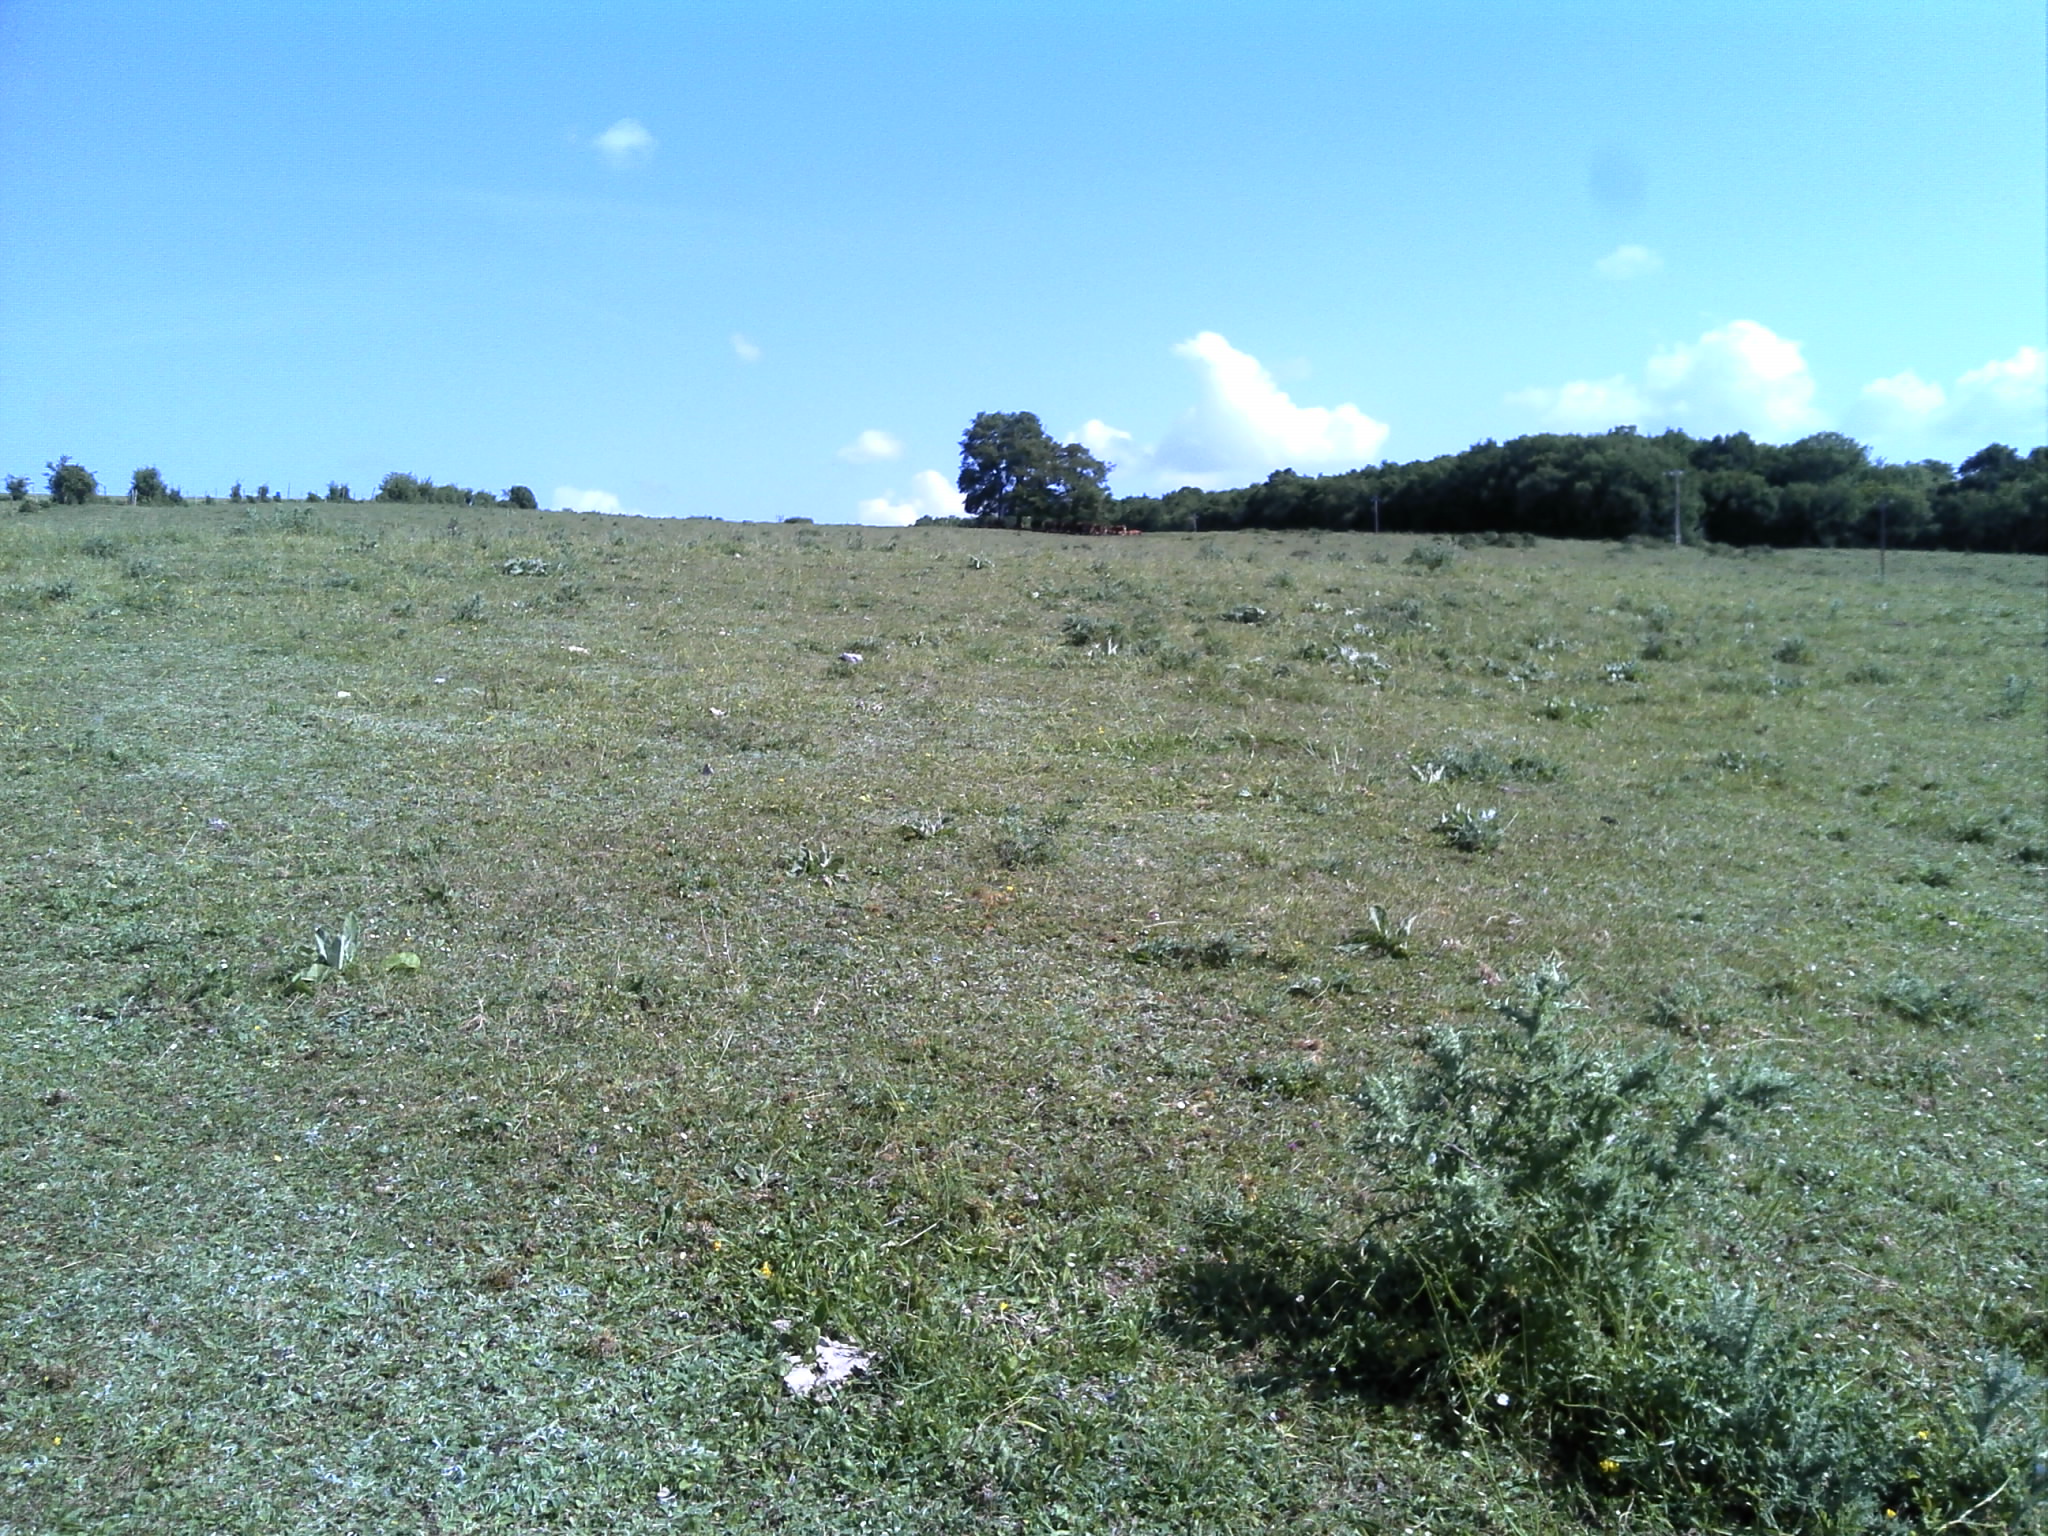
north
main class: Grassland
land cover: Grassland without tree/shrub cover
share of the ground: > 75 %
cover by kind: herbaceous plants 100 %
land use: Agriculture (excluding fallow land and kitchen gardens)
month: May
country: FR
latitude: 46.6331
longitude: 1.5645
